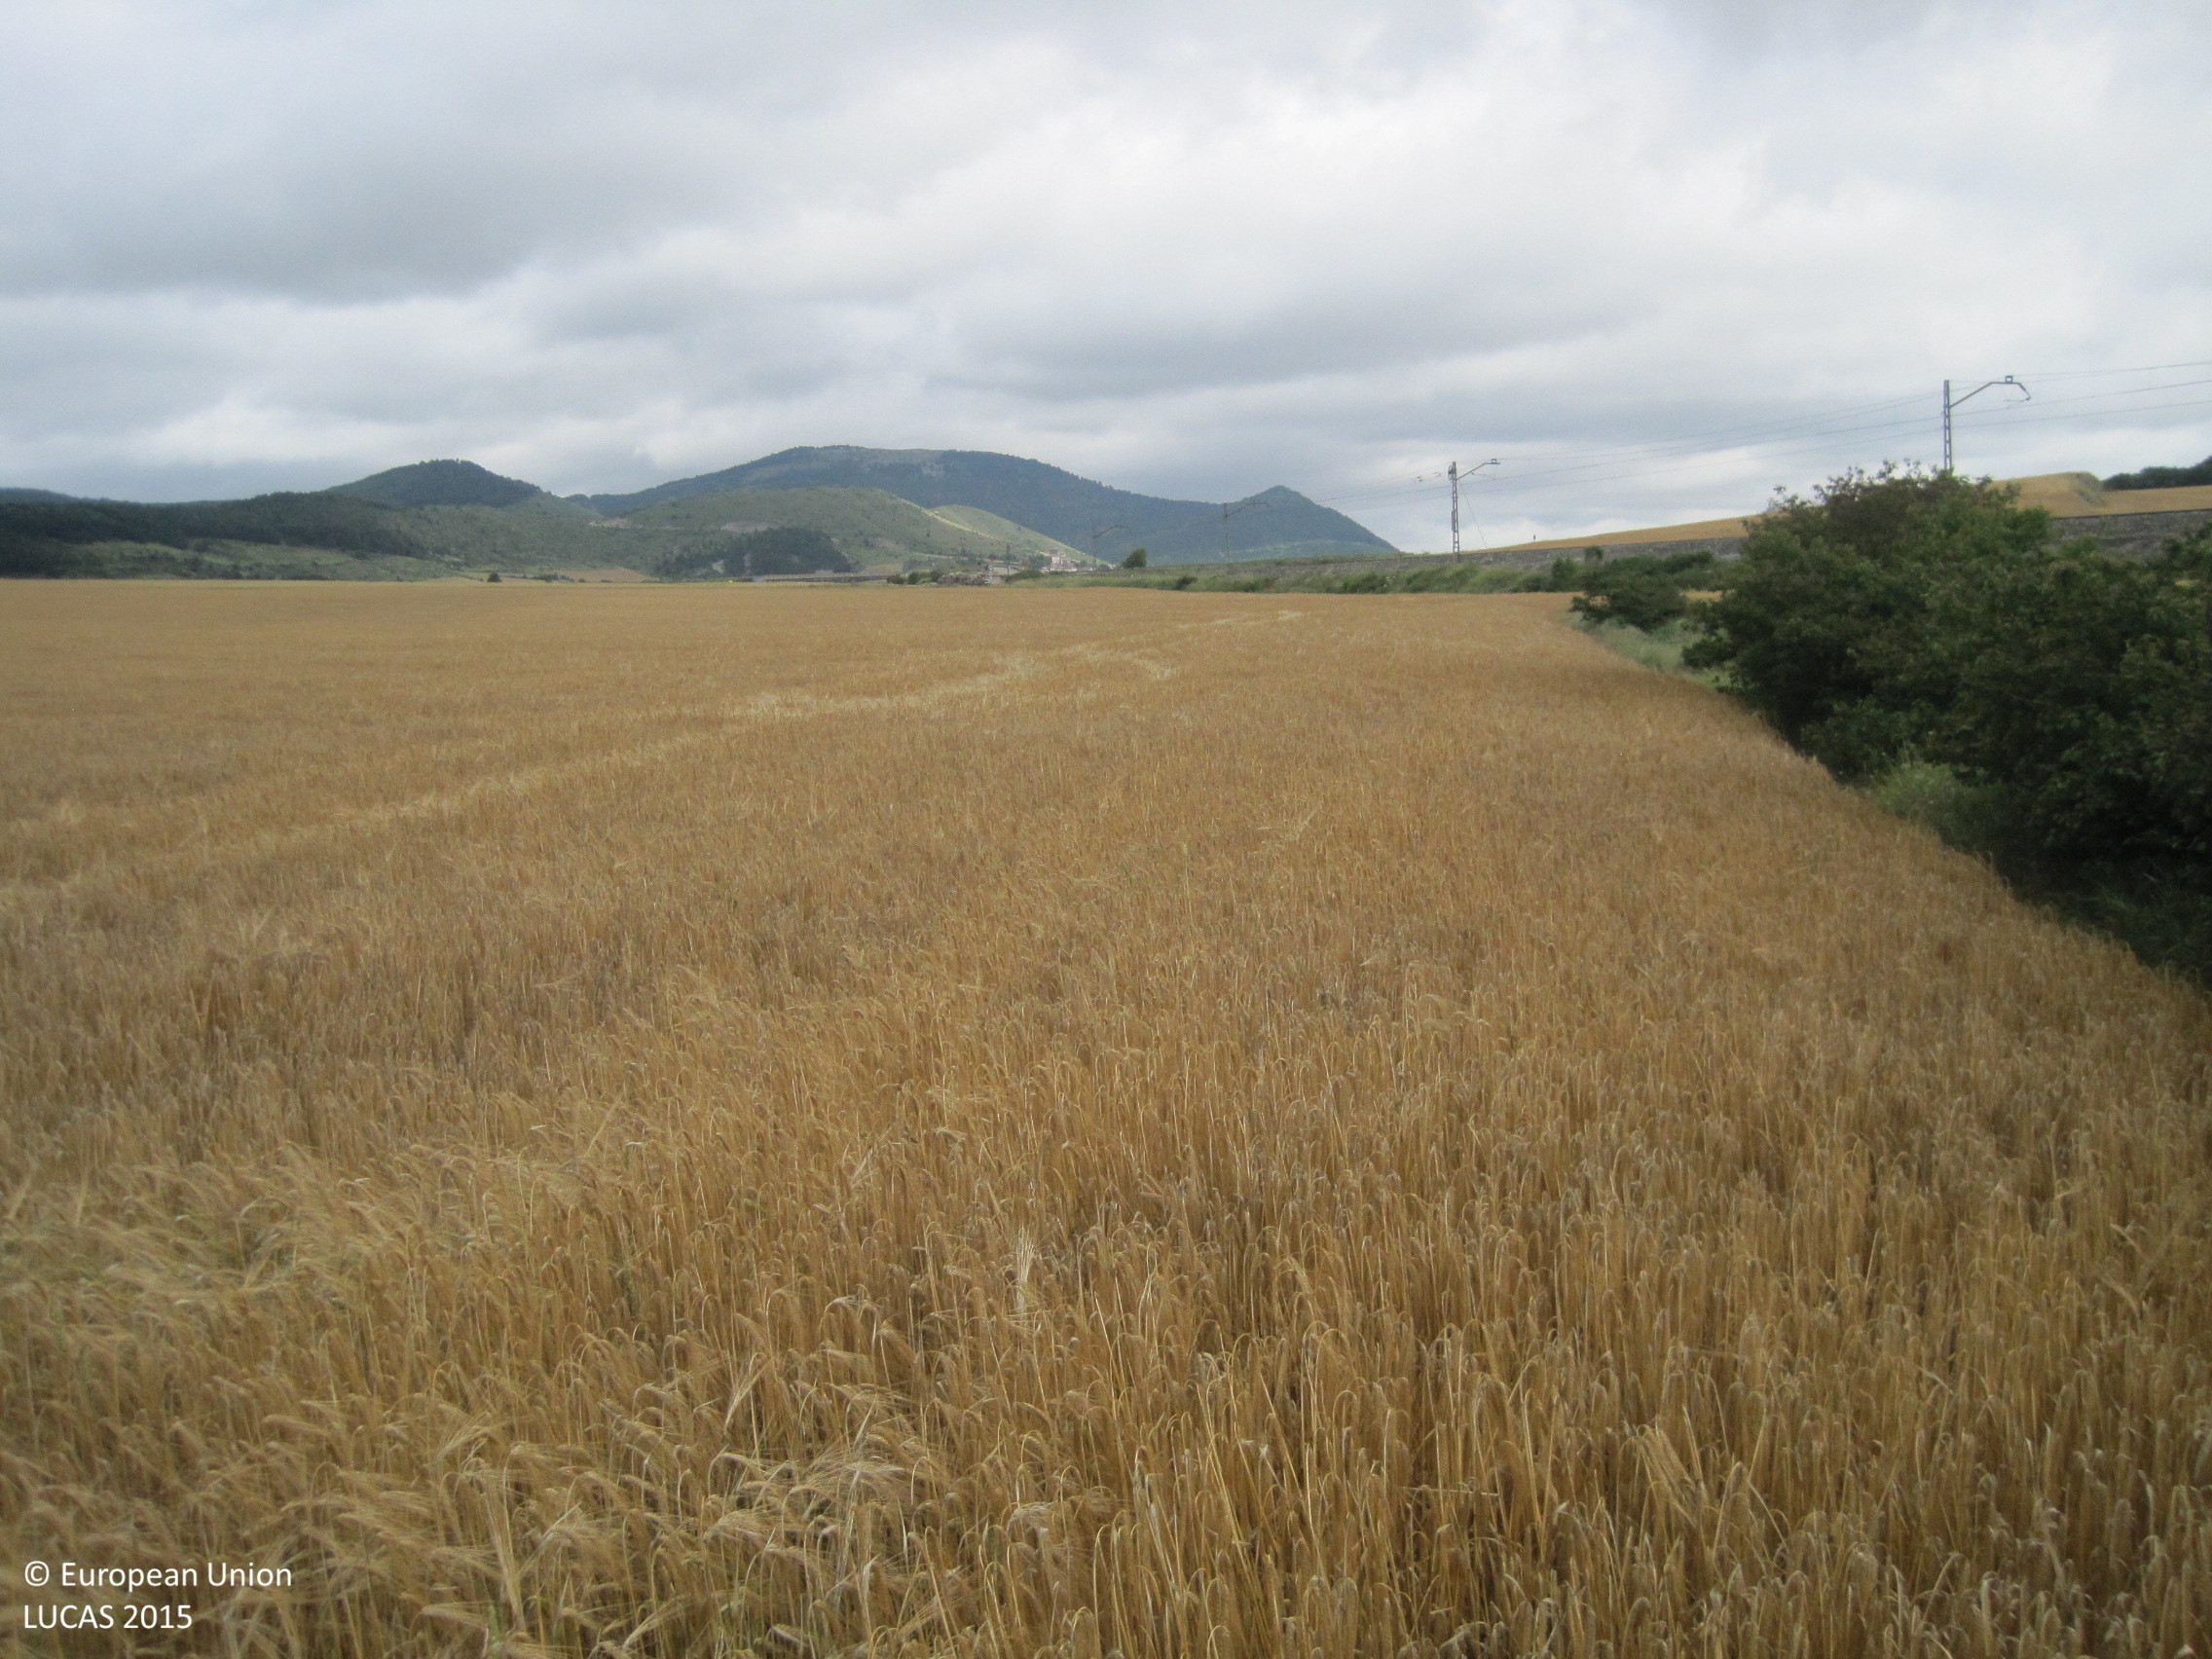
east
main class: Cropland
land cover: Barley
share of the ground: > 75 %
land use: Agriculture (excluding fallow land and kitchen gardens)
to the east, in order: Barley; Shruby margins; Electric lines; Railways; Grassland without tree/shrub cover; Barley
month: June
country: ES
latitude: 42.8753
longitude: -1.7811
